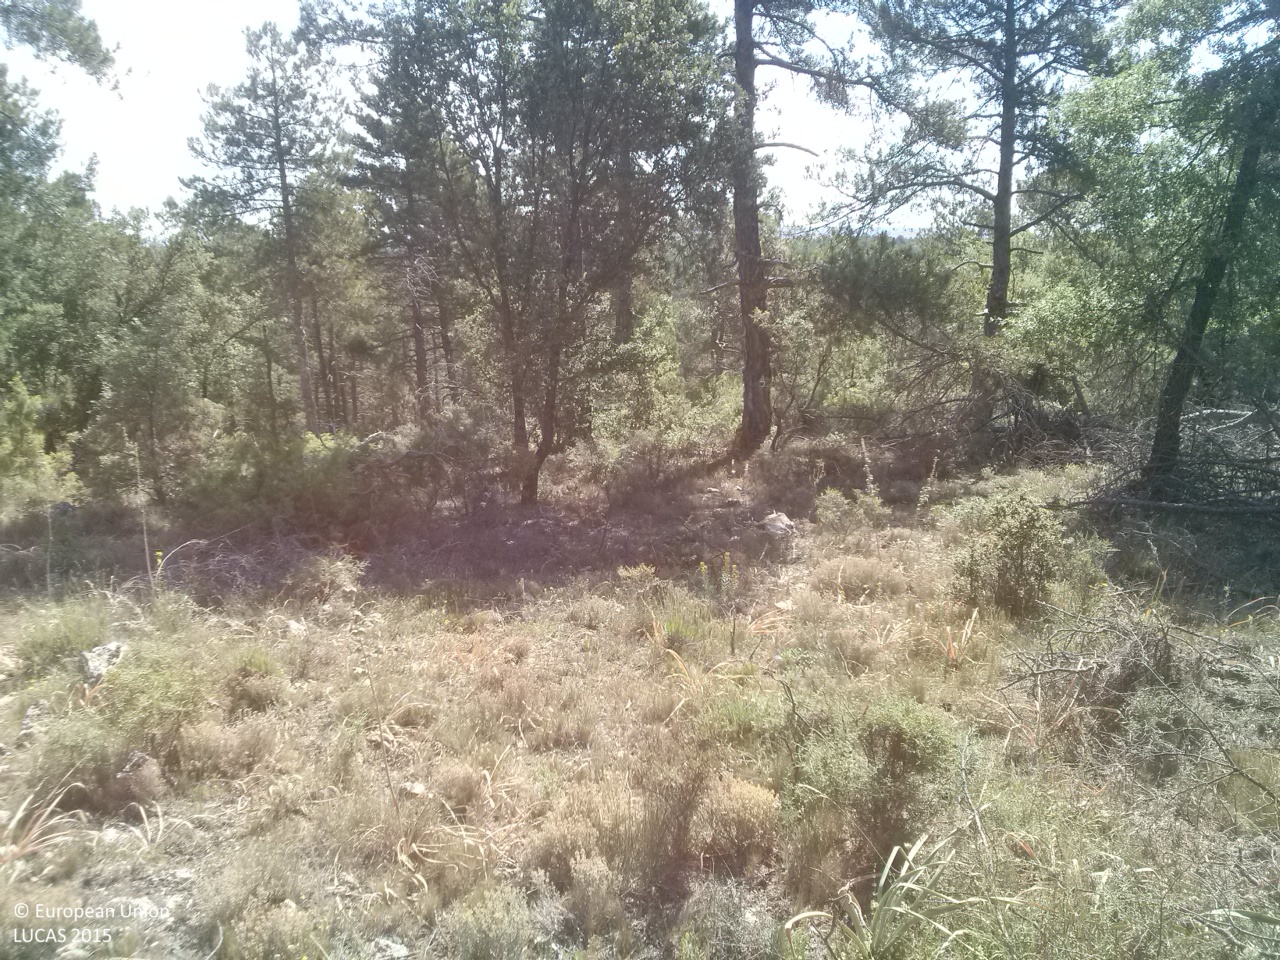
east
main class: Woodland
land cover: Pine dominated mixed woodland
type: coniferous forest of the mediterranean region
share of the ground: 10 - 25 %
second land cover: Shrubland without tree cover
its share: 25 - 50 %
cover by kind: shrubs 40 %, herbaceous plants 30 %, coniferous forest trees 20 %, broadleaved forest trees 10 %
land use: Forestry
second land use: Agriculture (excluding fallow land and kitchen gardens)
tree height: > 5 m
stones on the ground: 25 - 50 %
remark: Clear cut
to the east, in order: Pine dominated mixed woodland; Shrubland without tree cover; Pine dominated mixed woodland; Pine dominated coniferous woodland
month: June
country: ES
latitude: 39.9768
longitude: -1.6143
